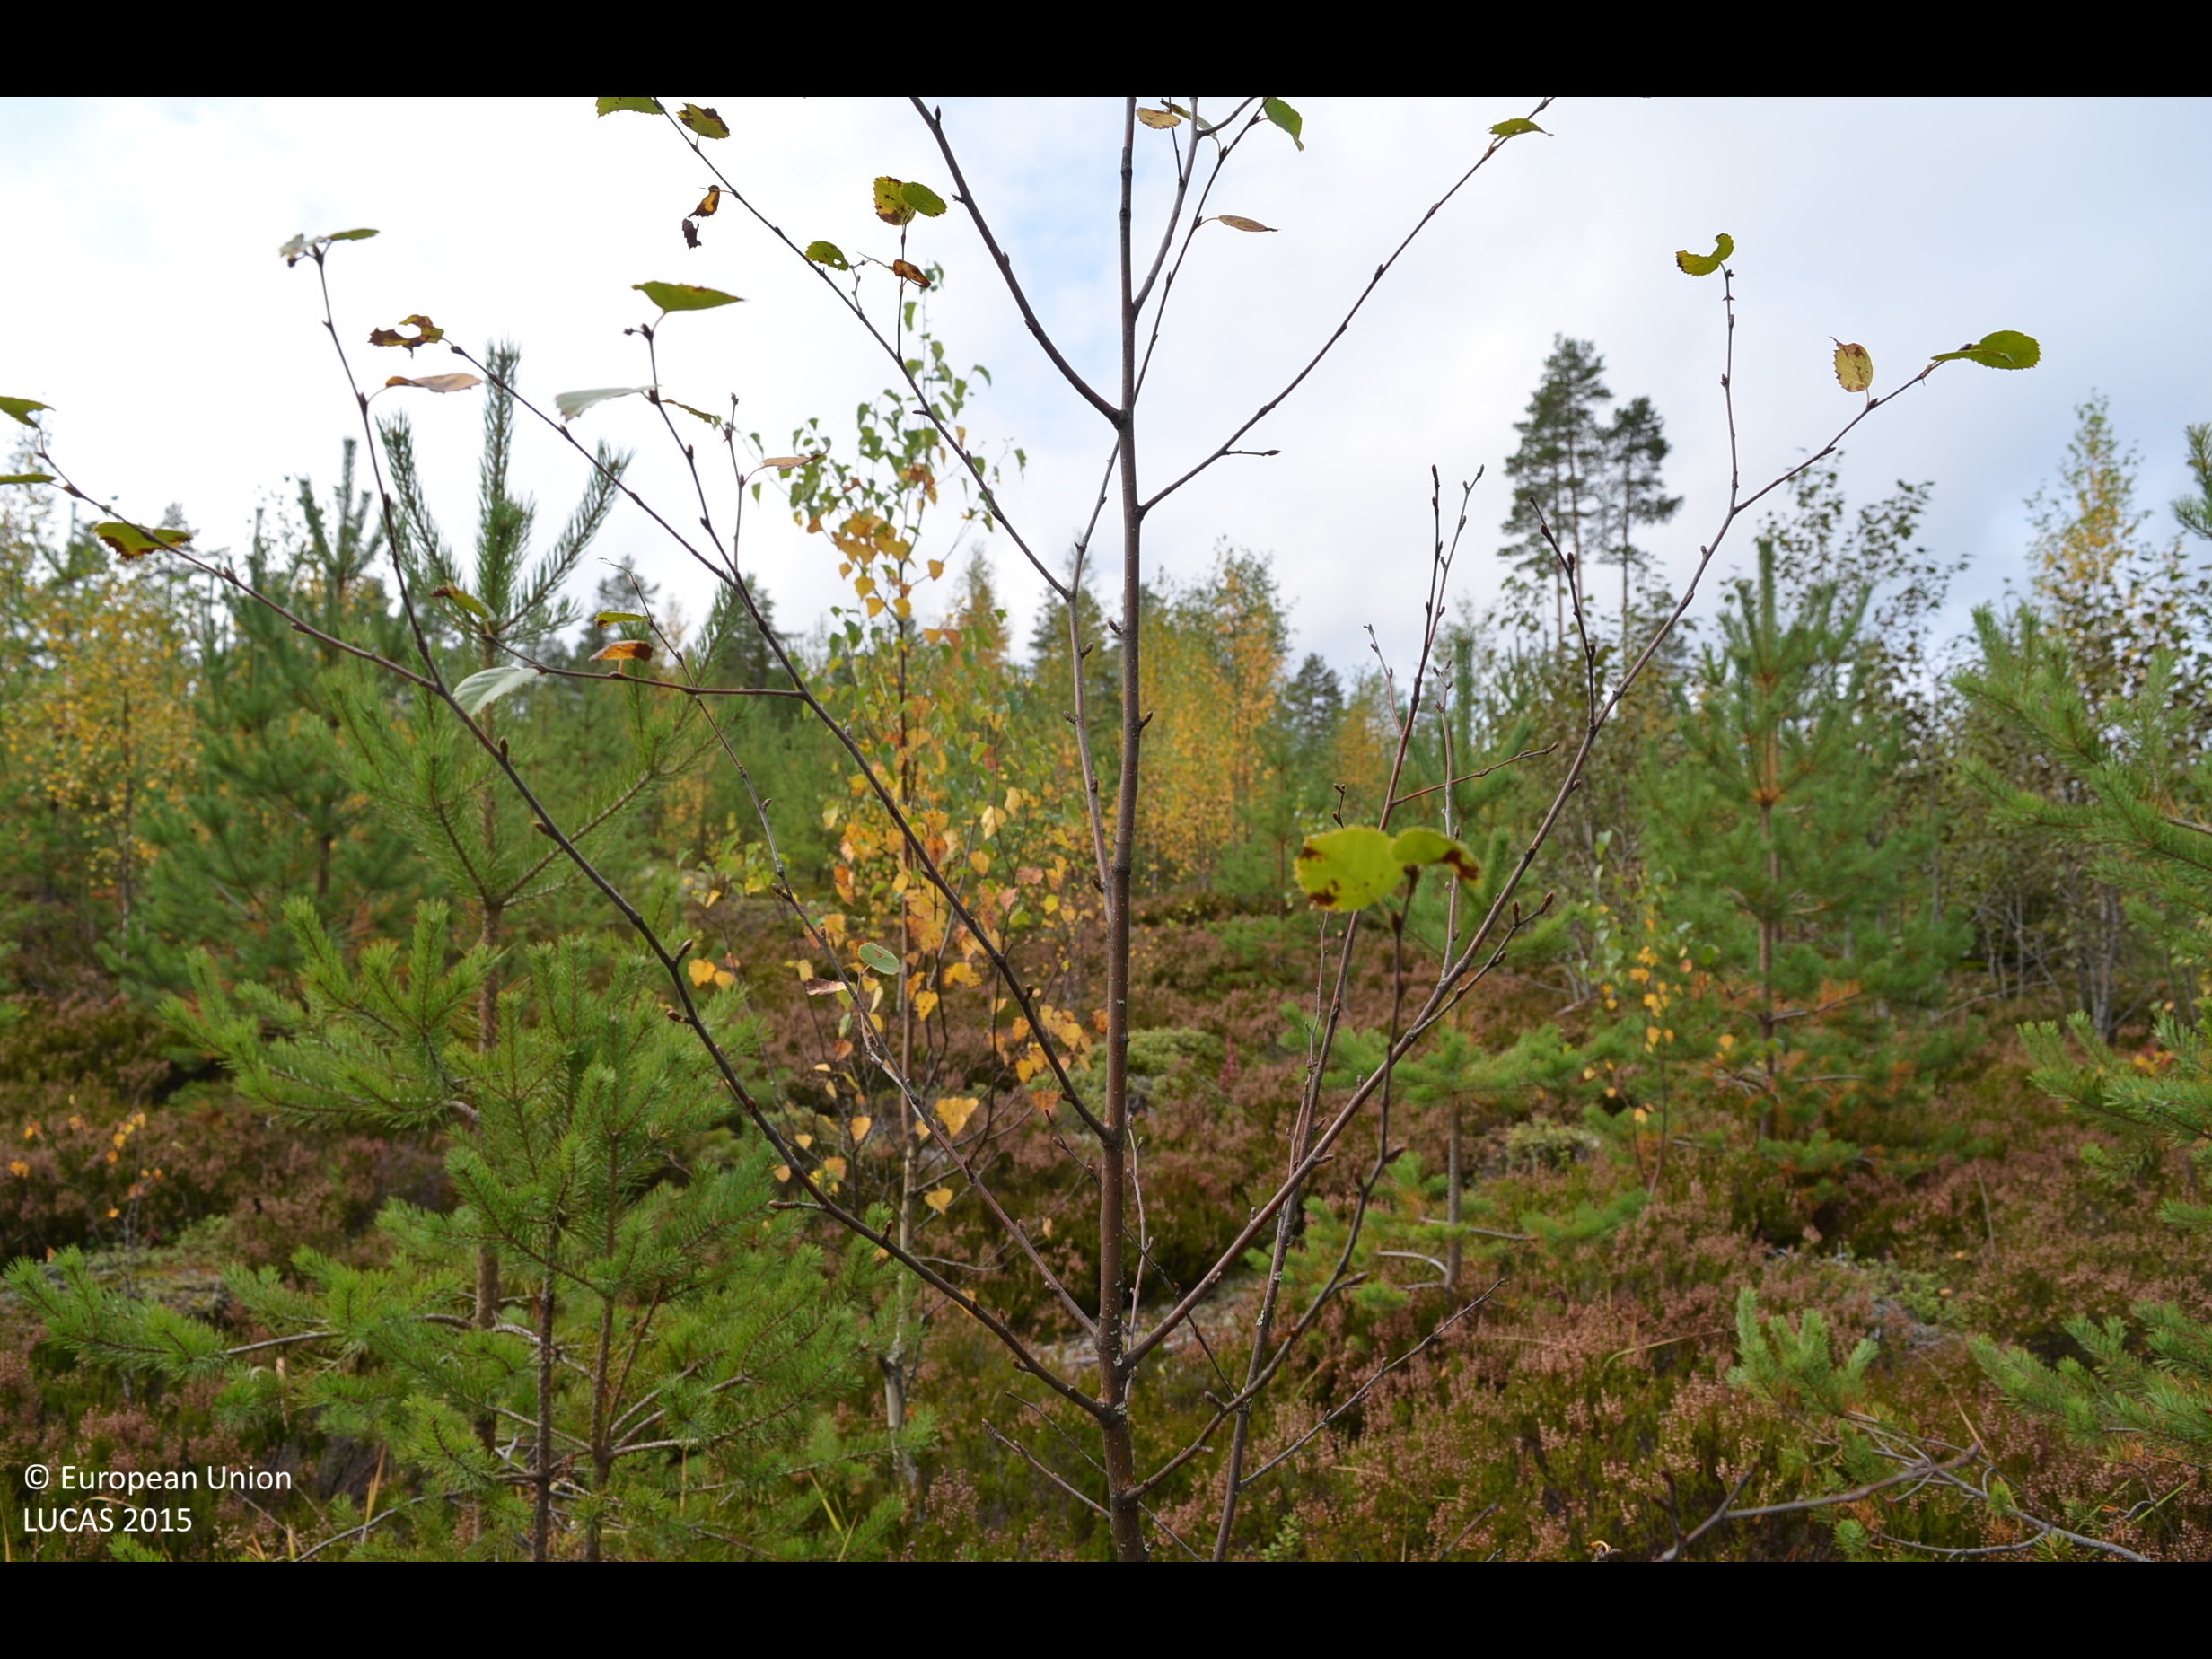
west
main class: Woodland
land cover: Pine dominated mixed woodland
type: boreal forest
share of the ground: 50 - 75 %
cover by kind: coniferous forest trees 35 %, shrubs 30 %, broadleaved forest trees 25 %, lichens and mosses 10 %
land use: Forestry
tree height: < 5 m
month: September
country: FI
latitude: 62.7269
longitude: 23.7865
